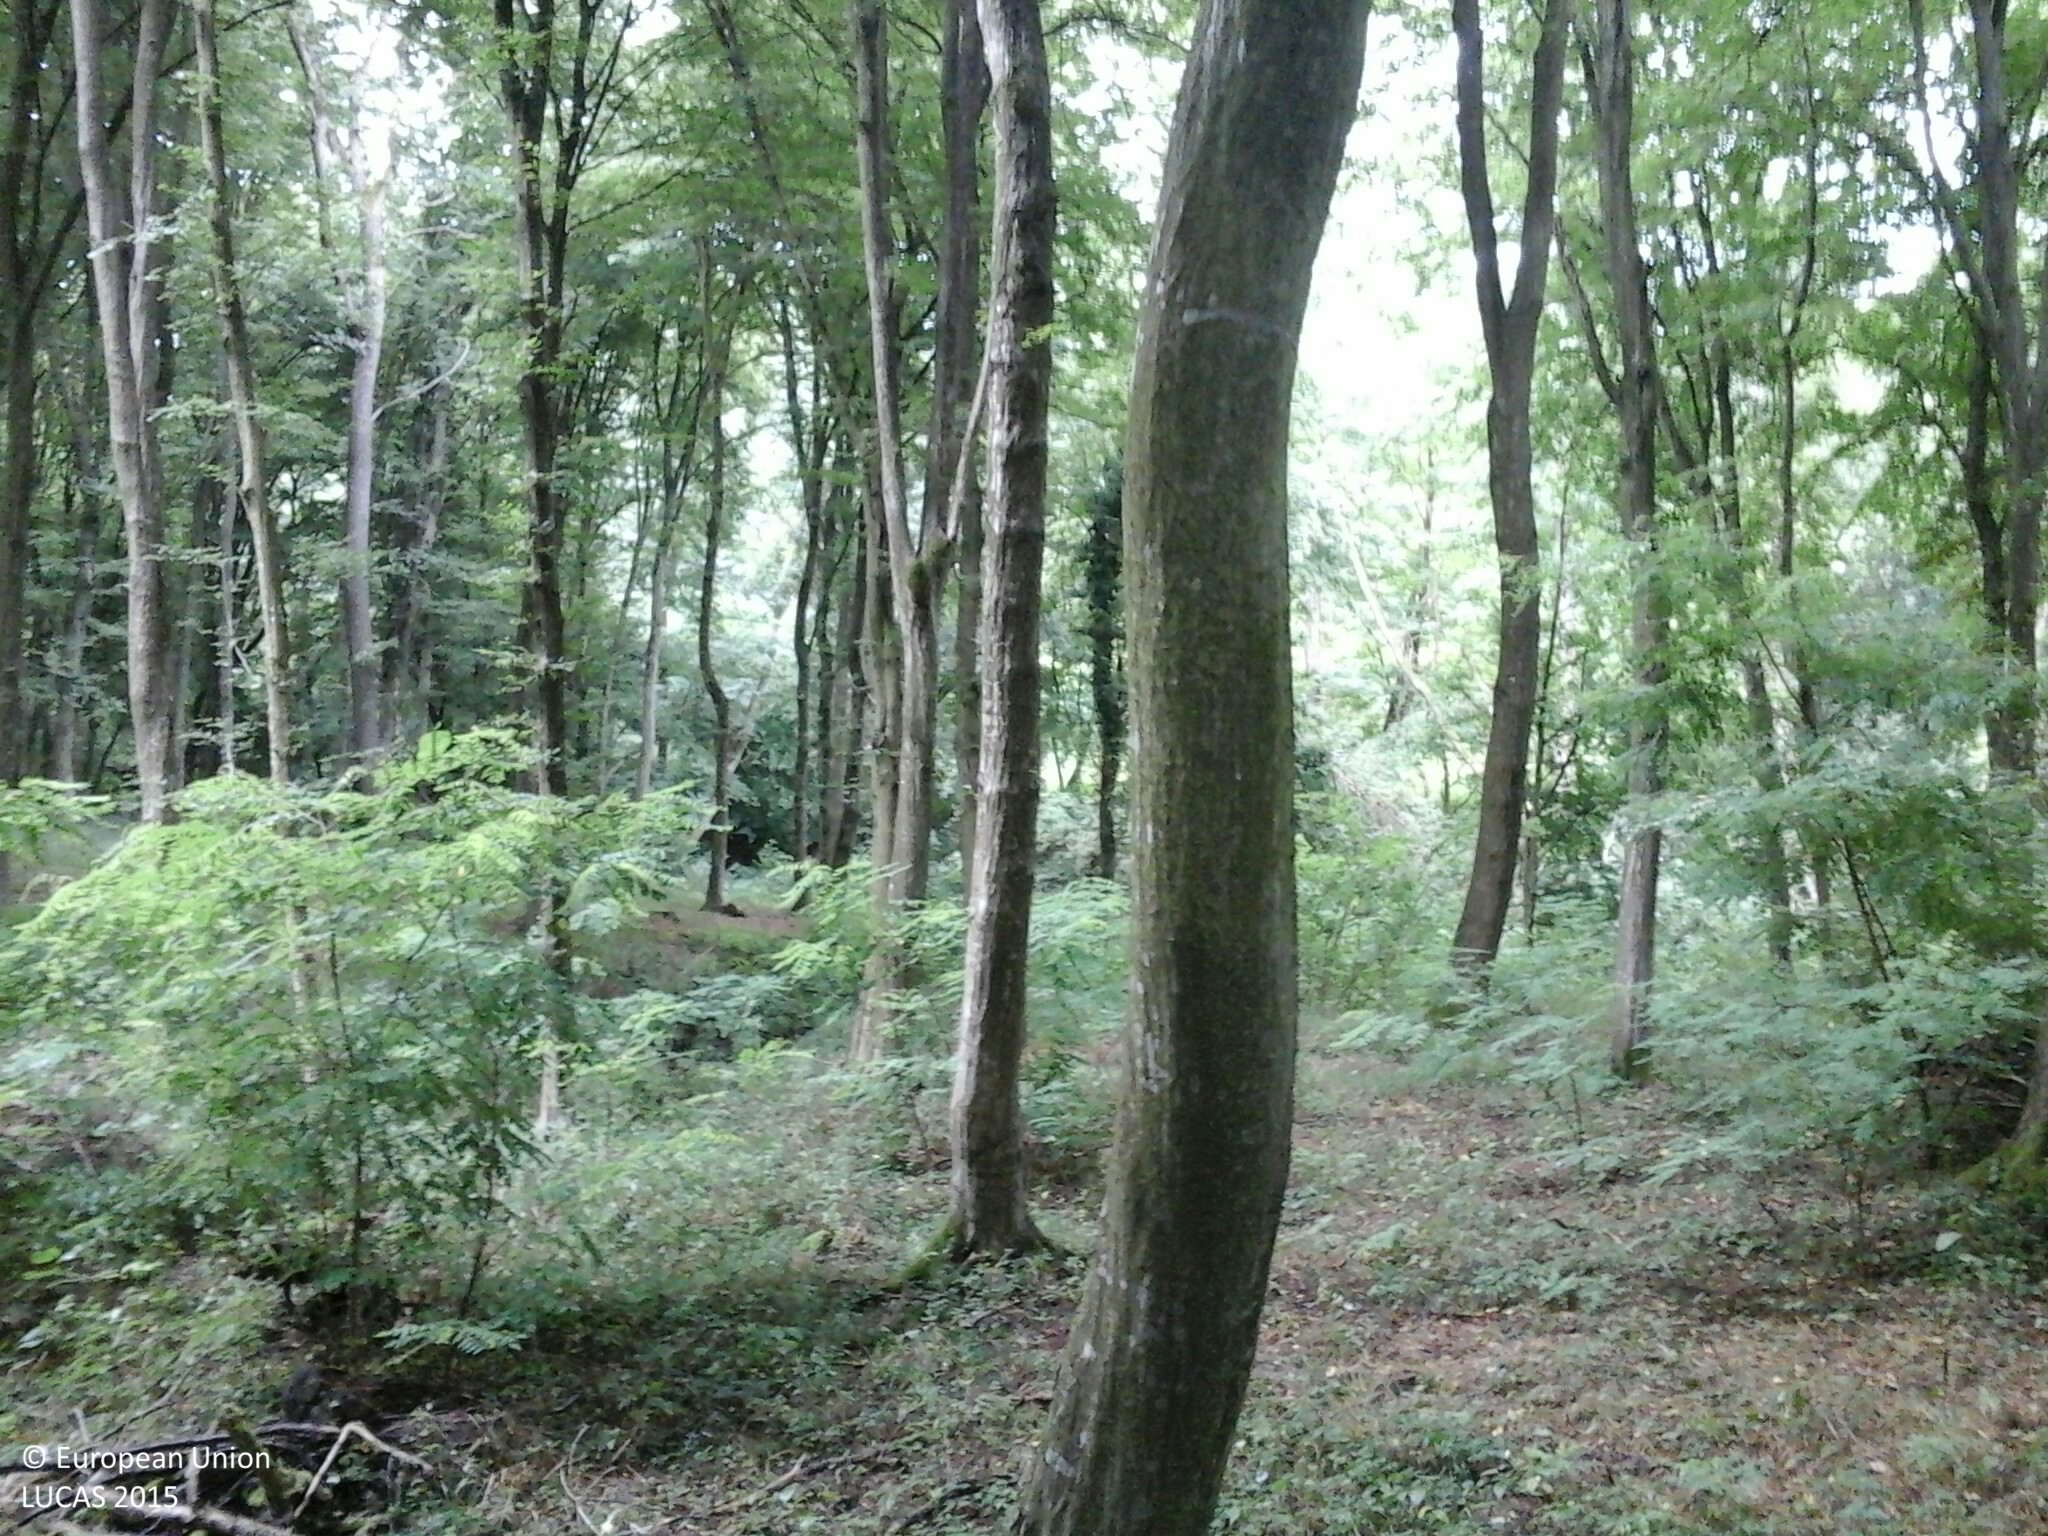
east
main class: Woodland
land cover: Broadleaved woodland
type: beech forest
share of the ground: 50 - 75 %
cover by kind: broadleaved forest trees 65 %, shrubs 25 %, herbaceous plants 10 %
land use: Forestry
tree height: > 5 m
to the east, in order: Broadleaved woodland; Rivers and streams; Shrubland with sparse tree cover; Tracks; Broadleaved woodland; Pine dominated coniferous woodland; Fences; Maize
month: July
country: HU
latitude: 46.8356
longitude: 16.5709
